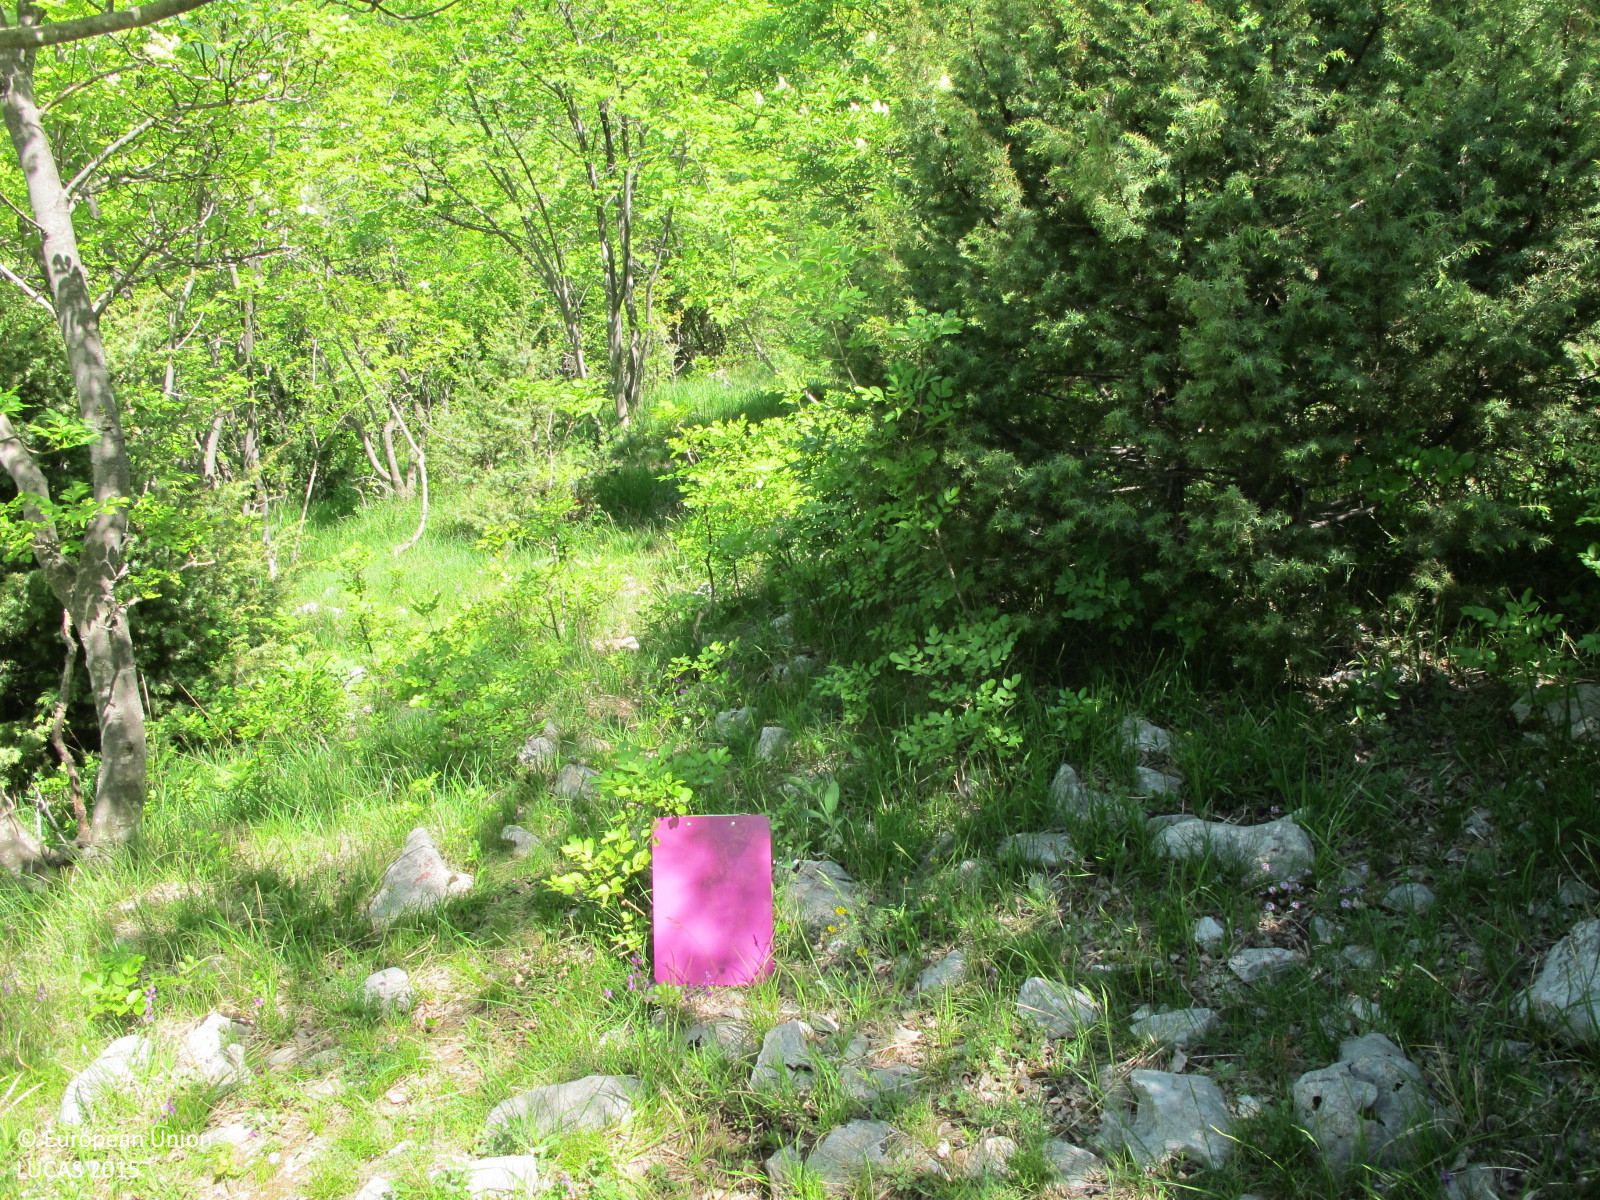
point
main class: Woodland
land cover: Broadleaved woodland
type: mesophytic deciduous forest
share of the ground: > 75 %
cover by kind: broadleaved forest trees 70 %, coniferous forest trees 10 %, shrubs 10 %, herbaceous plants 5 %, consolidated bare surface 5 %
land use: Forestry
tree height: < 5 m
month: May
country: HR
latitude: 45.1587
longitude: 14.8414
